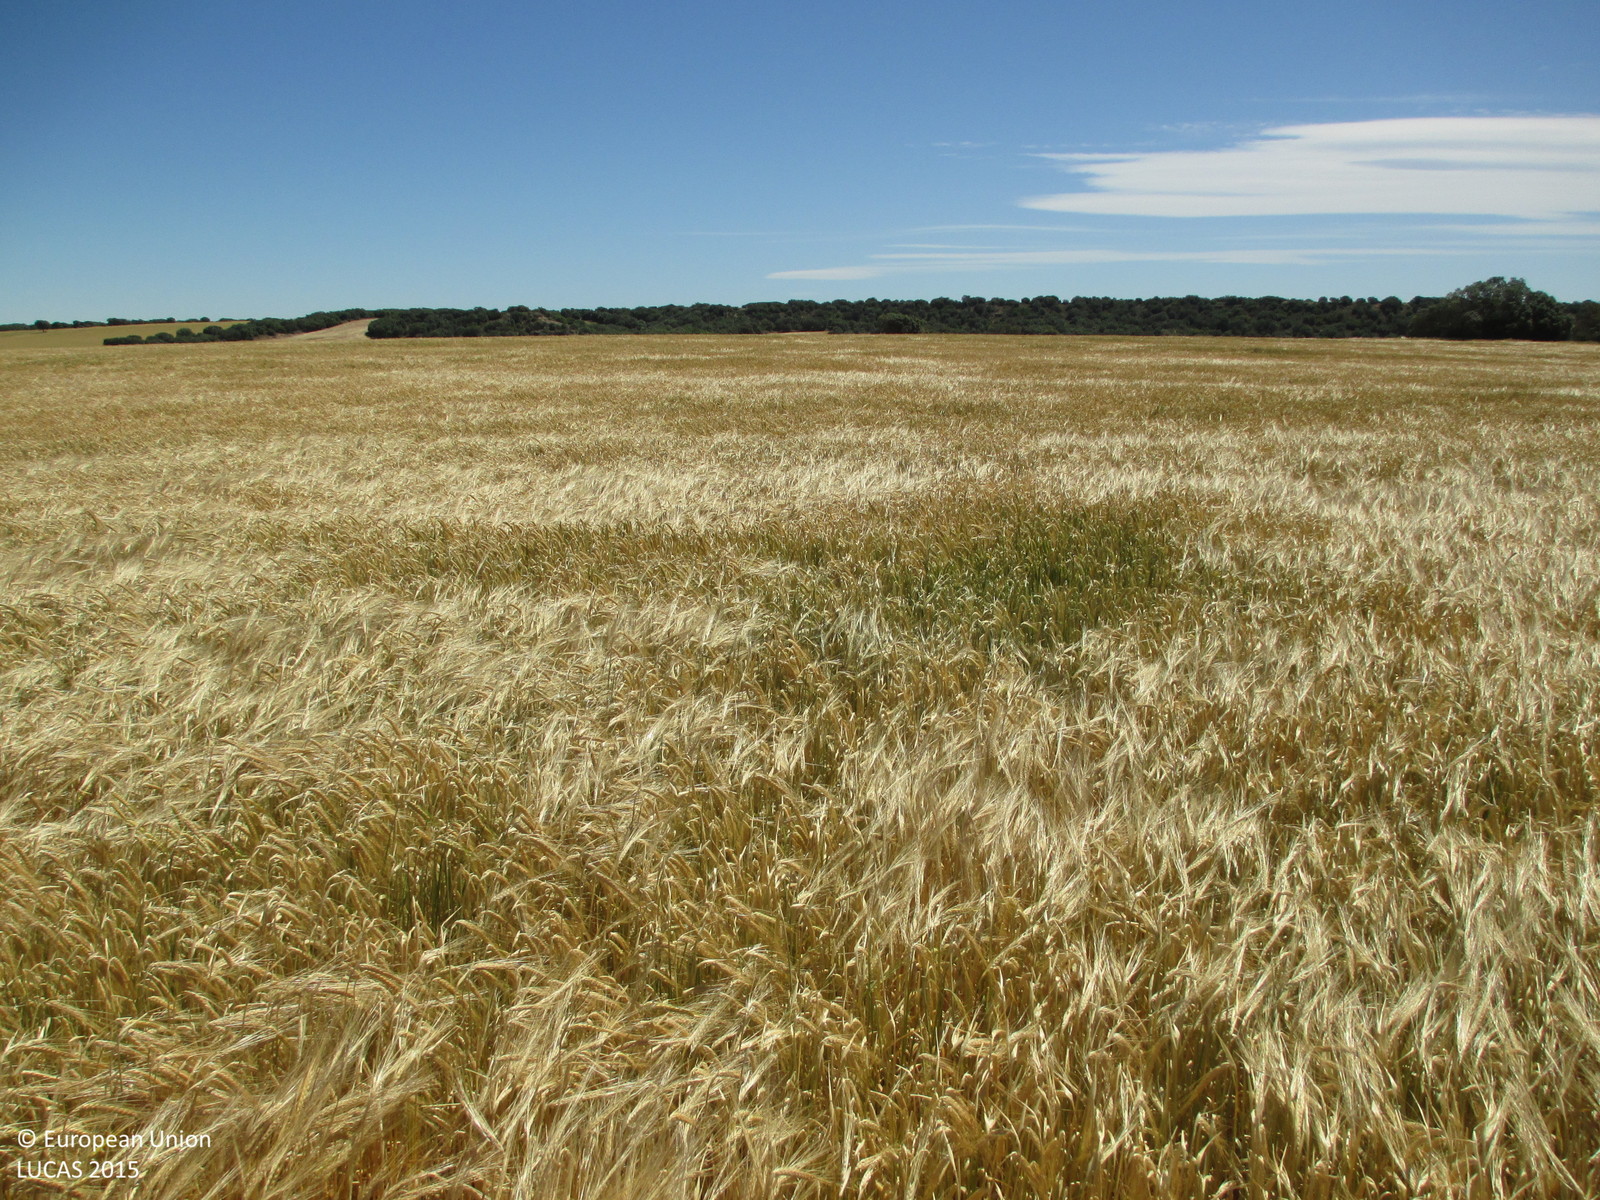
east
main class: Cropland
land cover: Barley
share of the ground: > 75 %
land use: Agriculture (excluding fallow land and kitchen gardens)
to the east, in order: Barley; Grass margins; Single bushes/trees; Barley
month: May
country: ES
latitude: 42.0235
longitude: -0.2499
